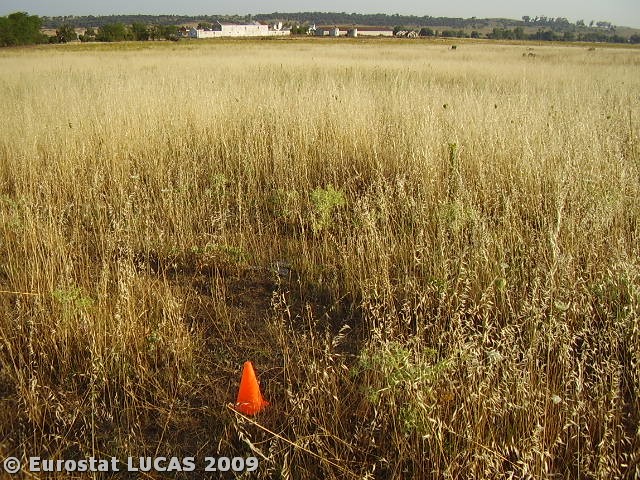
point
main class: Grassland
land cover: Spontaneously vegetated surfaces
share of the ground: > 75 %
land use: Fallow land
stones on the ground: 25 - 50 %
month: June
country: PT
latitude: 38.6508
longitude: -7.9557
